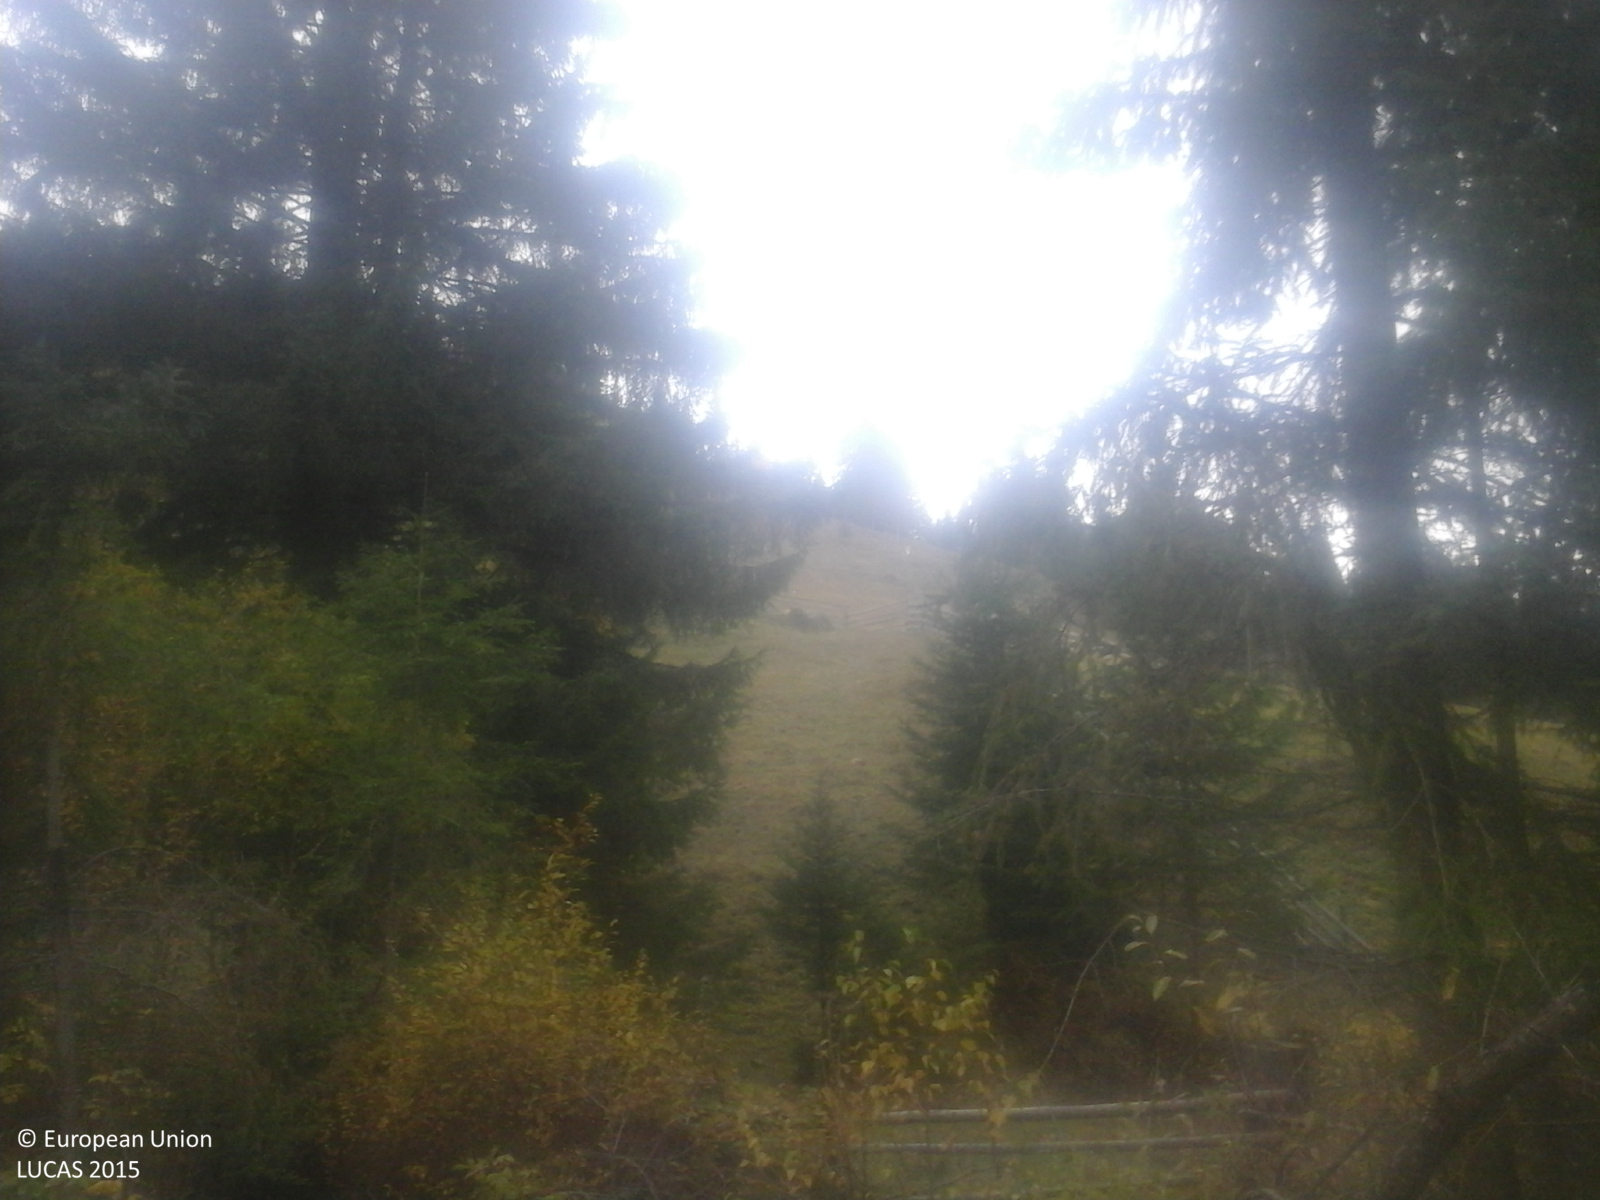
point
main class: Woodland
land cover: Spruce dominated coniferous woodland
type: alpine coniferous forest
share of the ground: 50 - 75 %
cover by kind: coniferous forest trees 60 %, herbaceous plants 40 %
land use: Forestry
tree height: > 5 m
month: October
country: RO
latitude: 47.2082
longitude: 25.3865
